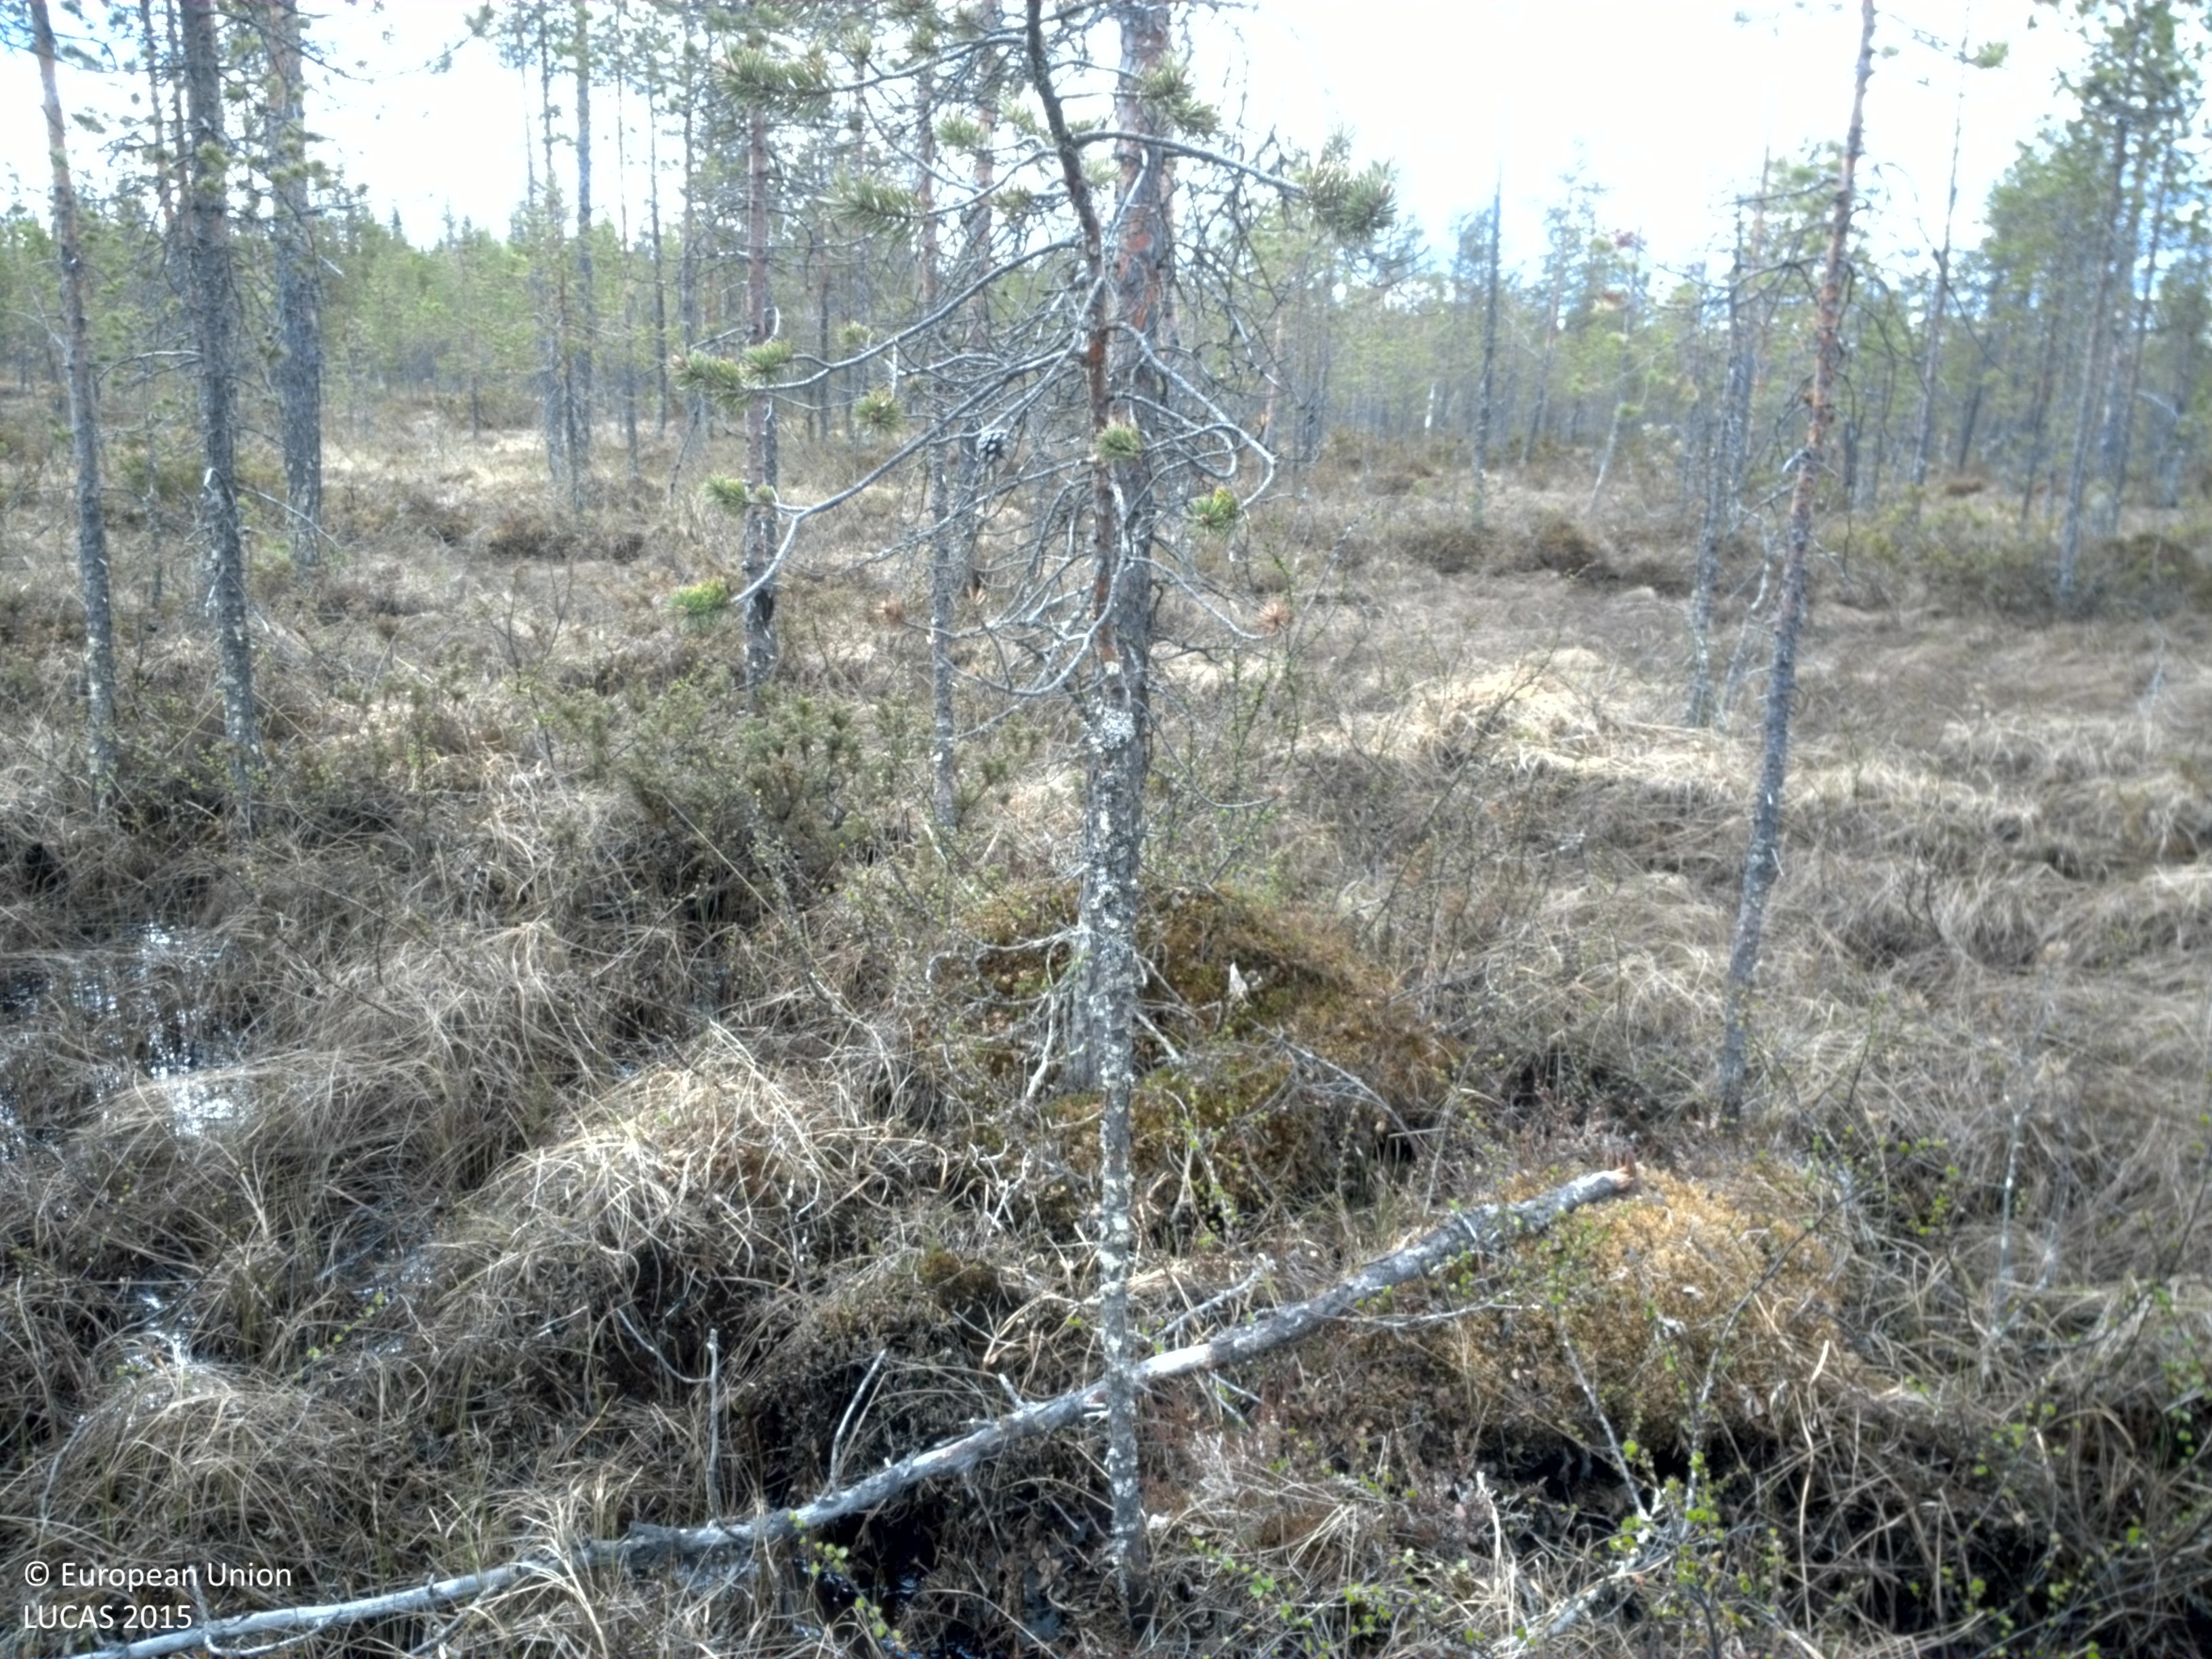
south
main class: Woodland
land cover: Pine dominated coniferous woodland
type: boreal forest
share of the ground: 25 - 50 %
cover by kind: shrubs 35 %, herbaceous plants 35 %, coniferous forest trees 25 %, lichens and mosses 5 %
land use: Forestry
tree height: > 5 m
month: June
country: SE
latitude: 66.9954
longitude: 21.3054
